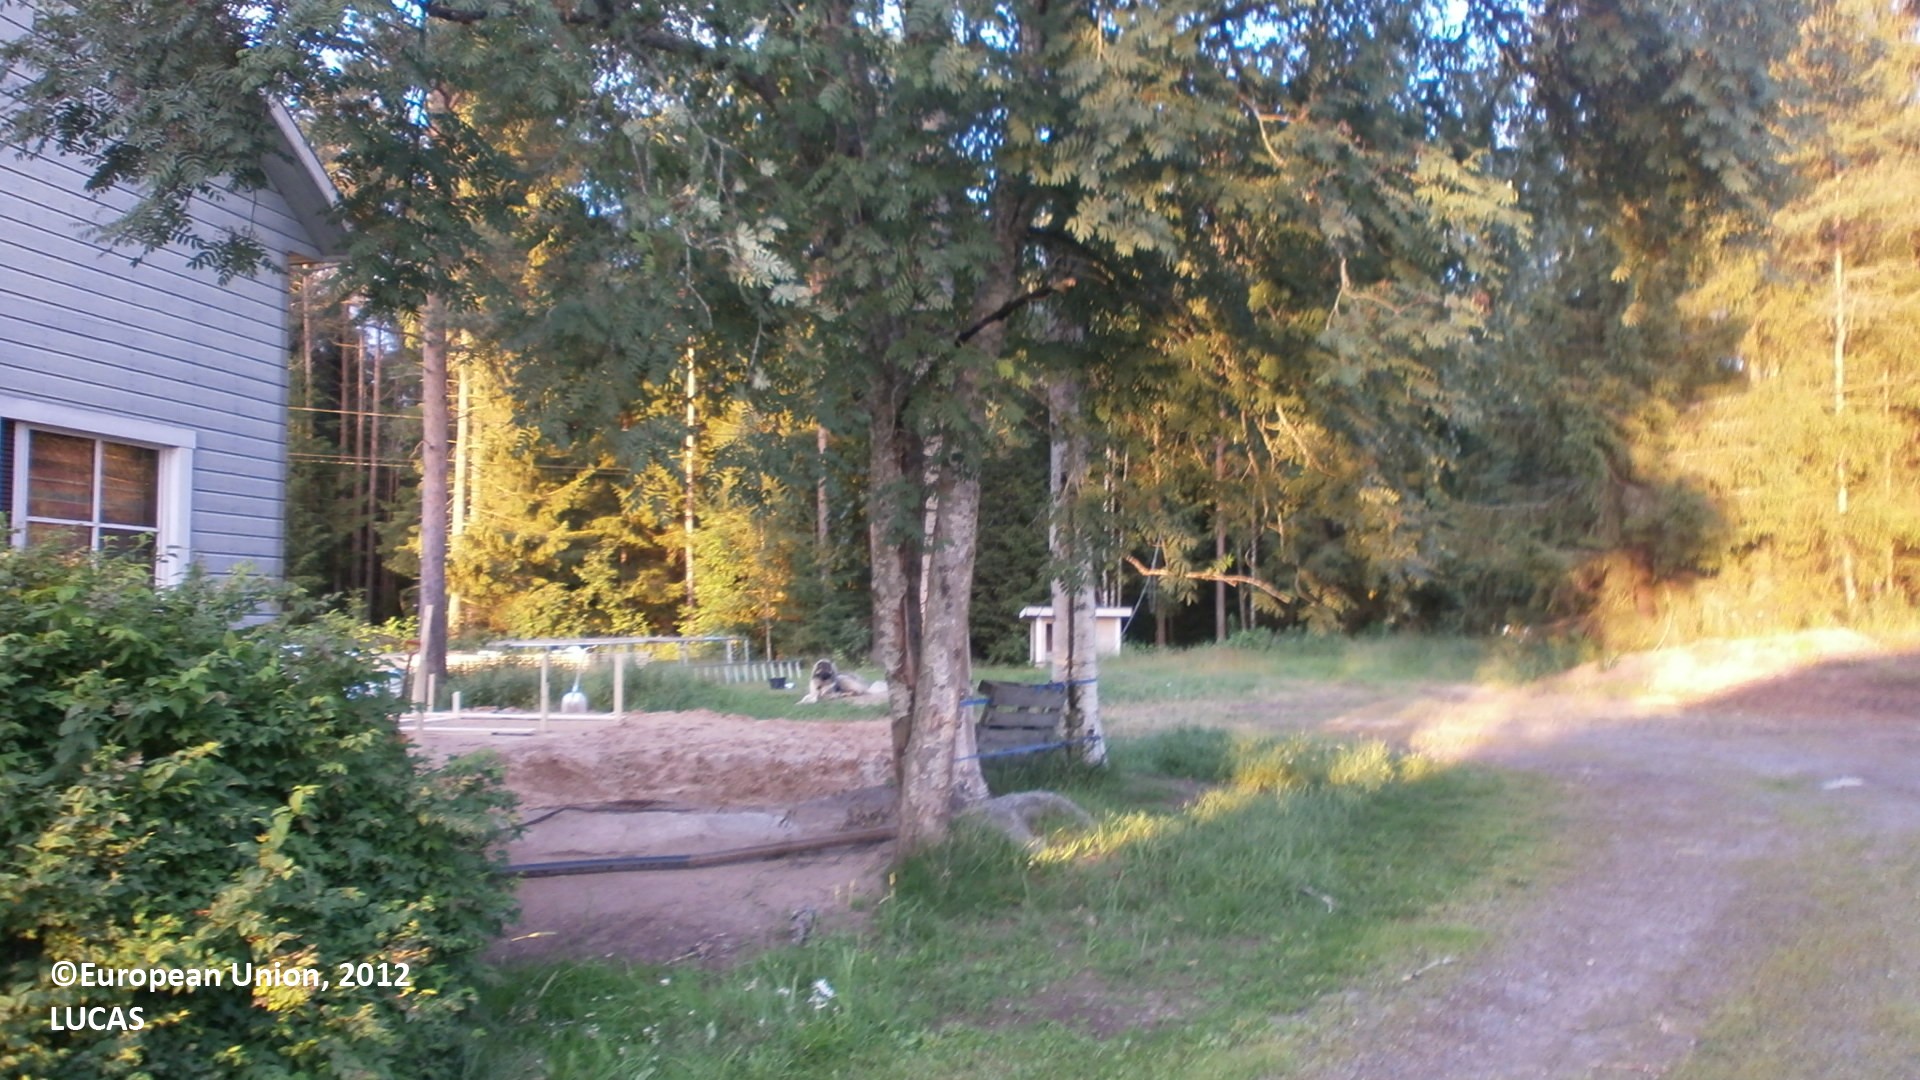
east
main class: Grassland
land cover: Grassland without tree/shrub cover
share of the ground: > 75 %
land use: Residential
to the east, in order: Grassland without tree/shrub cover; Artificial constructions in urban areas; Spruce dominated coniferous woodland; Electric lines; Spruce dominated coniferous woodland; Shrubland with sparse tree cover; Electric lines; Shrubland with sparse tree cover; Spruce dominated coniferous woodland; Electric lines; Spruce dominated mixed woodland; Artificial constructions in urban areas; Ditches and canals; Grass margins; Paved roads, cycling and walking lanes; Shruby margins; Ditches and canals; Electric lines; Fences; Temporary grasslands; Fences; Shruby margins; Ditches and canals; Spruce dominated coniferous woodland
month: July
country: FI
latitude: 64.1225
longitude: 24.0080
